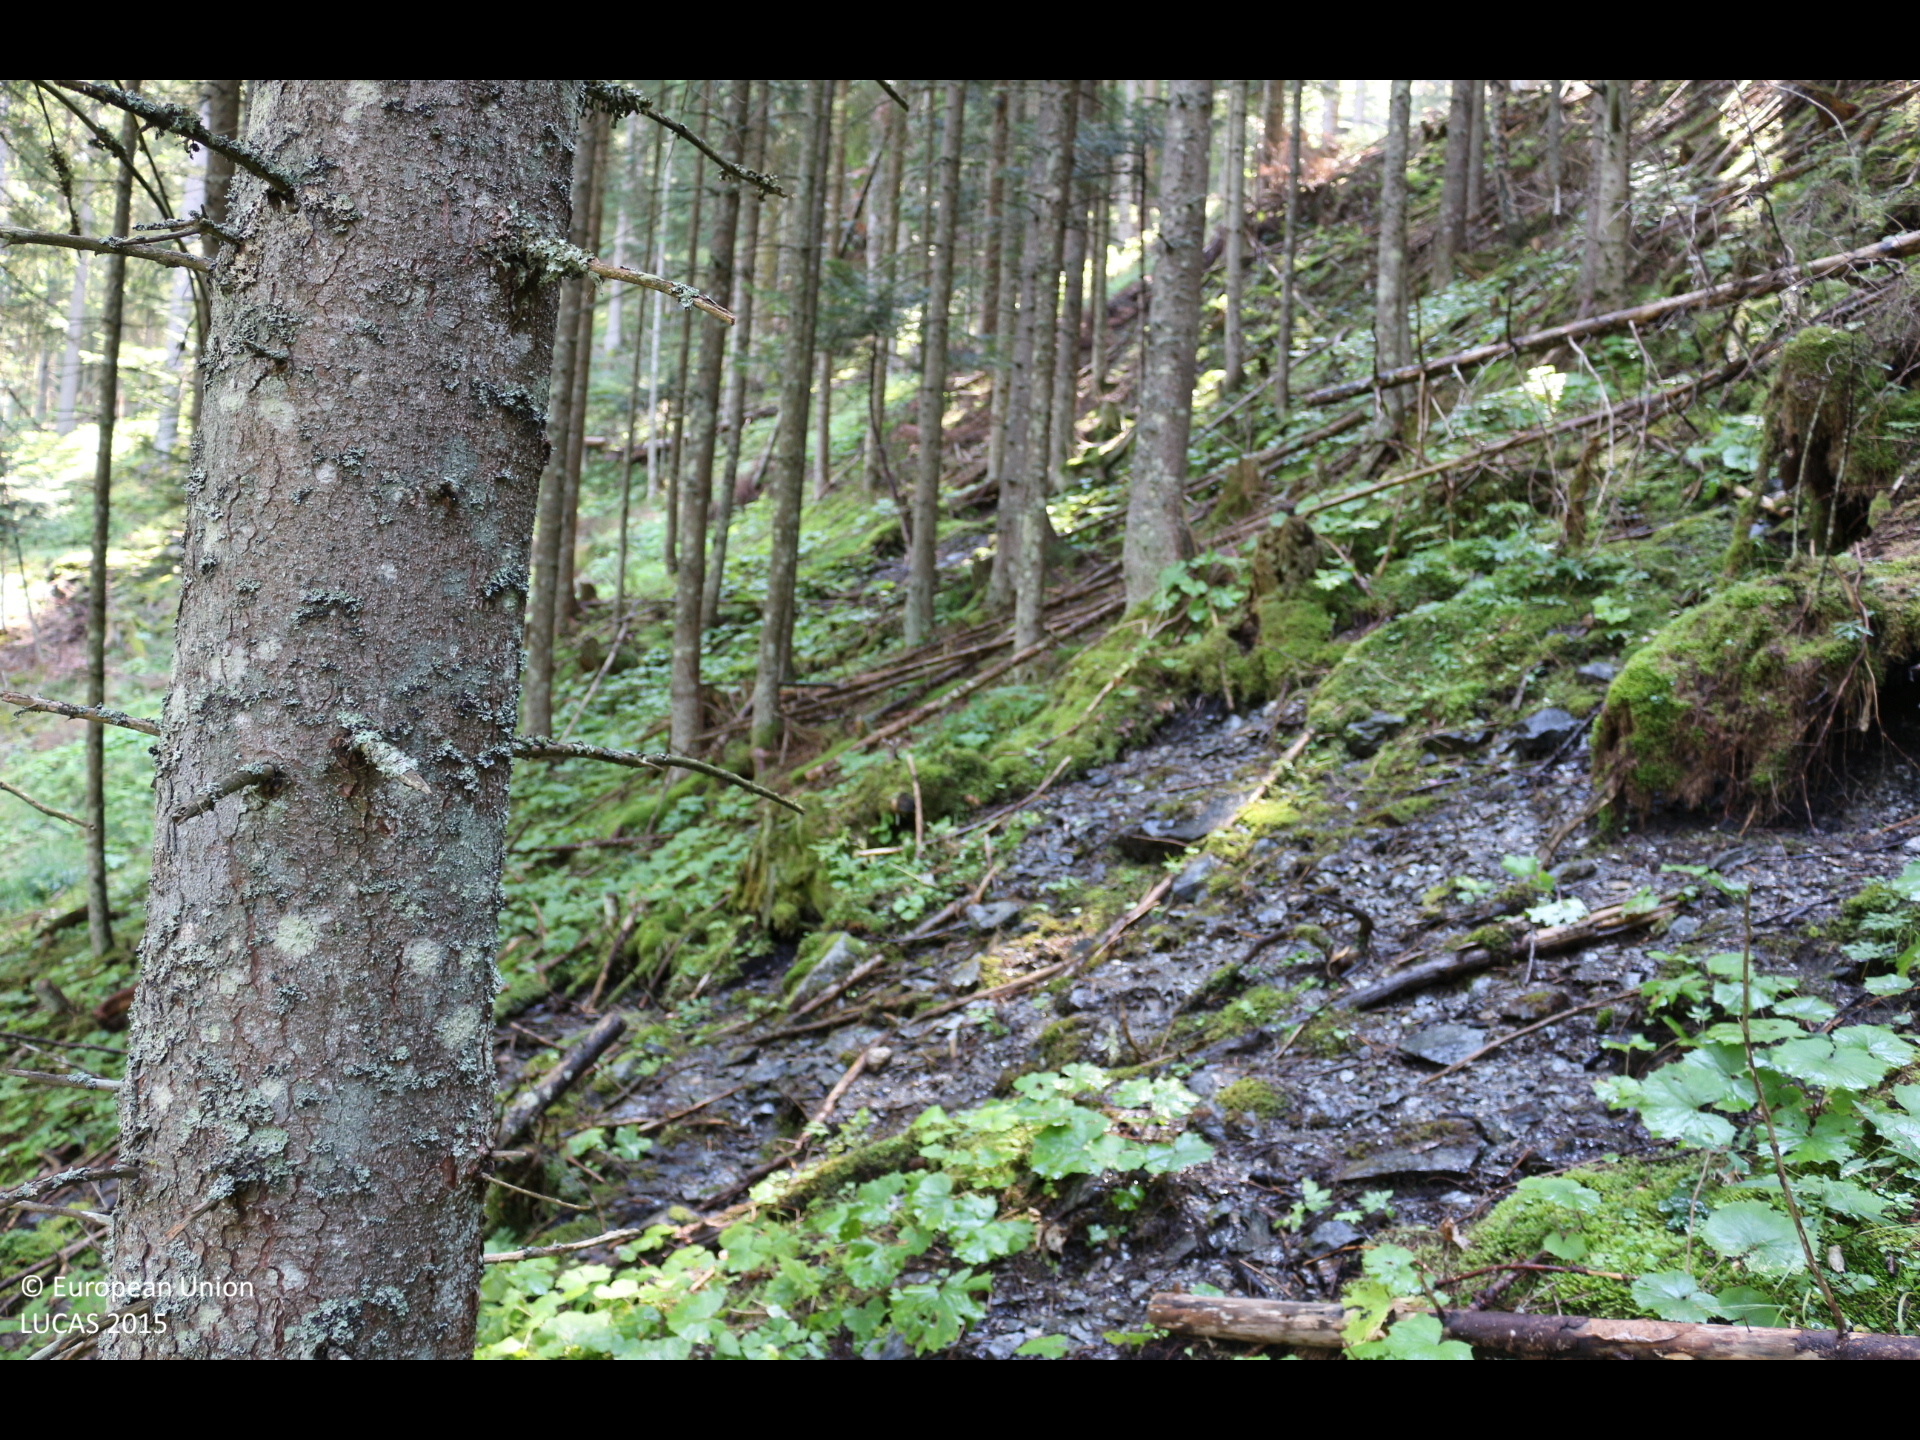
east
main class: Woodland
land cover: Spruce dominated coniferous woodland
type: alpine coniferous forest
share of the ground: > 75 %
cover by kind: coniferous forest trees 85 %, herbaceous plants 15 %
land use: Forestry
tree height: > 5 m
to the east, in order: Spruce dominated coniferous woodland; Rivers and streams; Spruce dominated coniferous woodland; Tracks; Spruce dominated coniferous woodland
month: August
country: AT
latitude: 46.7646
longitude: 13.9649
